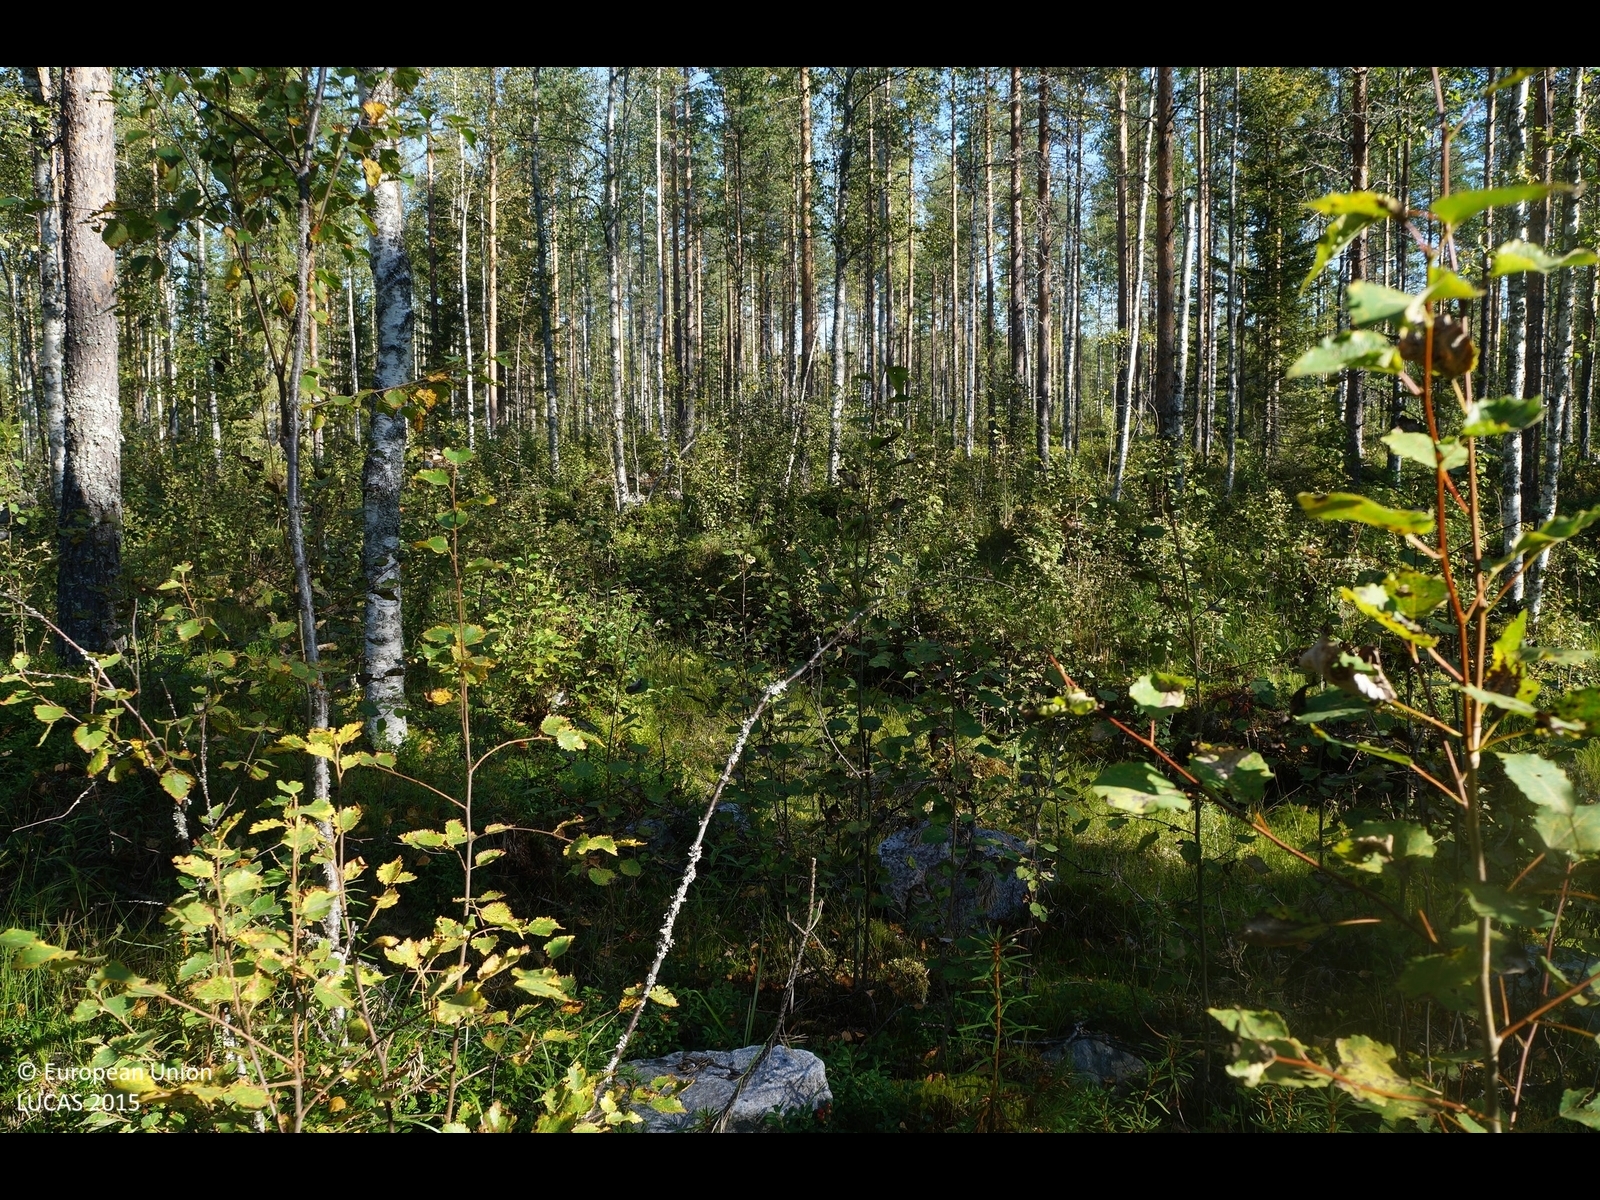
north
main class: Woodland
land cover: Pine dominated mixed woodland
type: boreal forest
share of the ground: 50 - 75 %
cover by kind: shrubs 30 %, coniferous forest trees 25 %, broadleaved forest trees 25 %, herbaceous plants 10 %, lichens and mosses 10 %
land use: Forestry
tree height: > 5 m
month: August
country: FI
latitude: 64.2850
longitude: 25.2276
